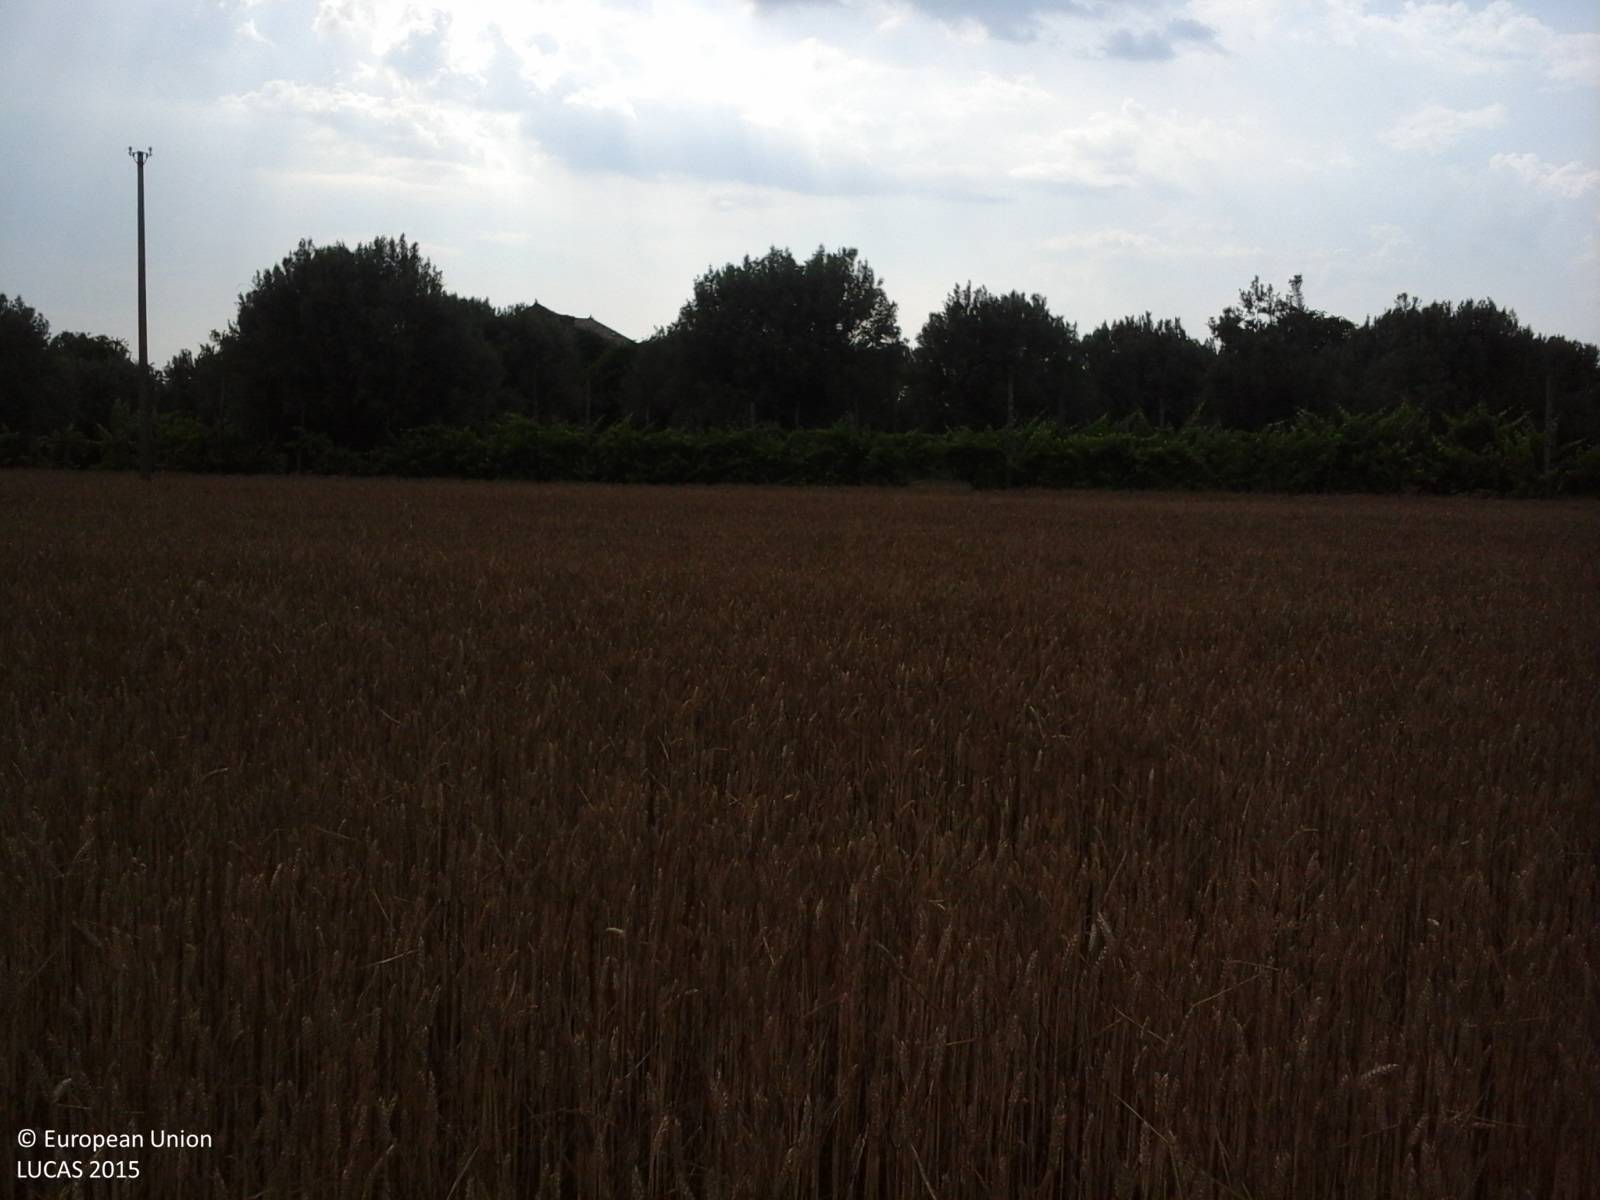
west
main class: Cropland
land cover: Common wheat
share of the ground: > 75 %
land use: Agriculture (excluding fallow land and kitchen gardens)
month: June
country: IT
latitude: 41.1580
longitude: 14.1426
